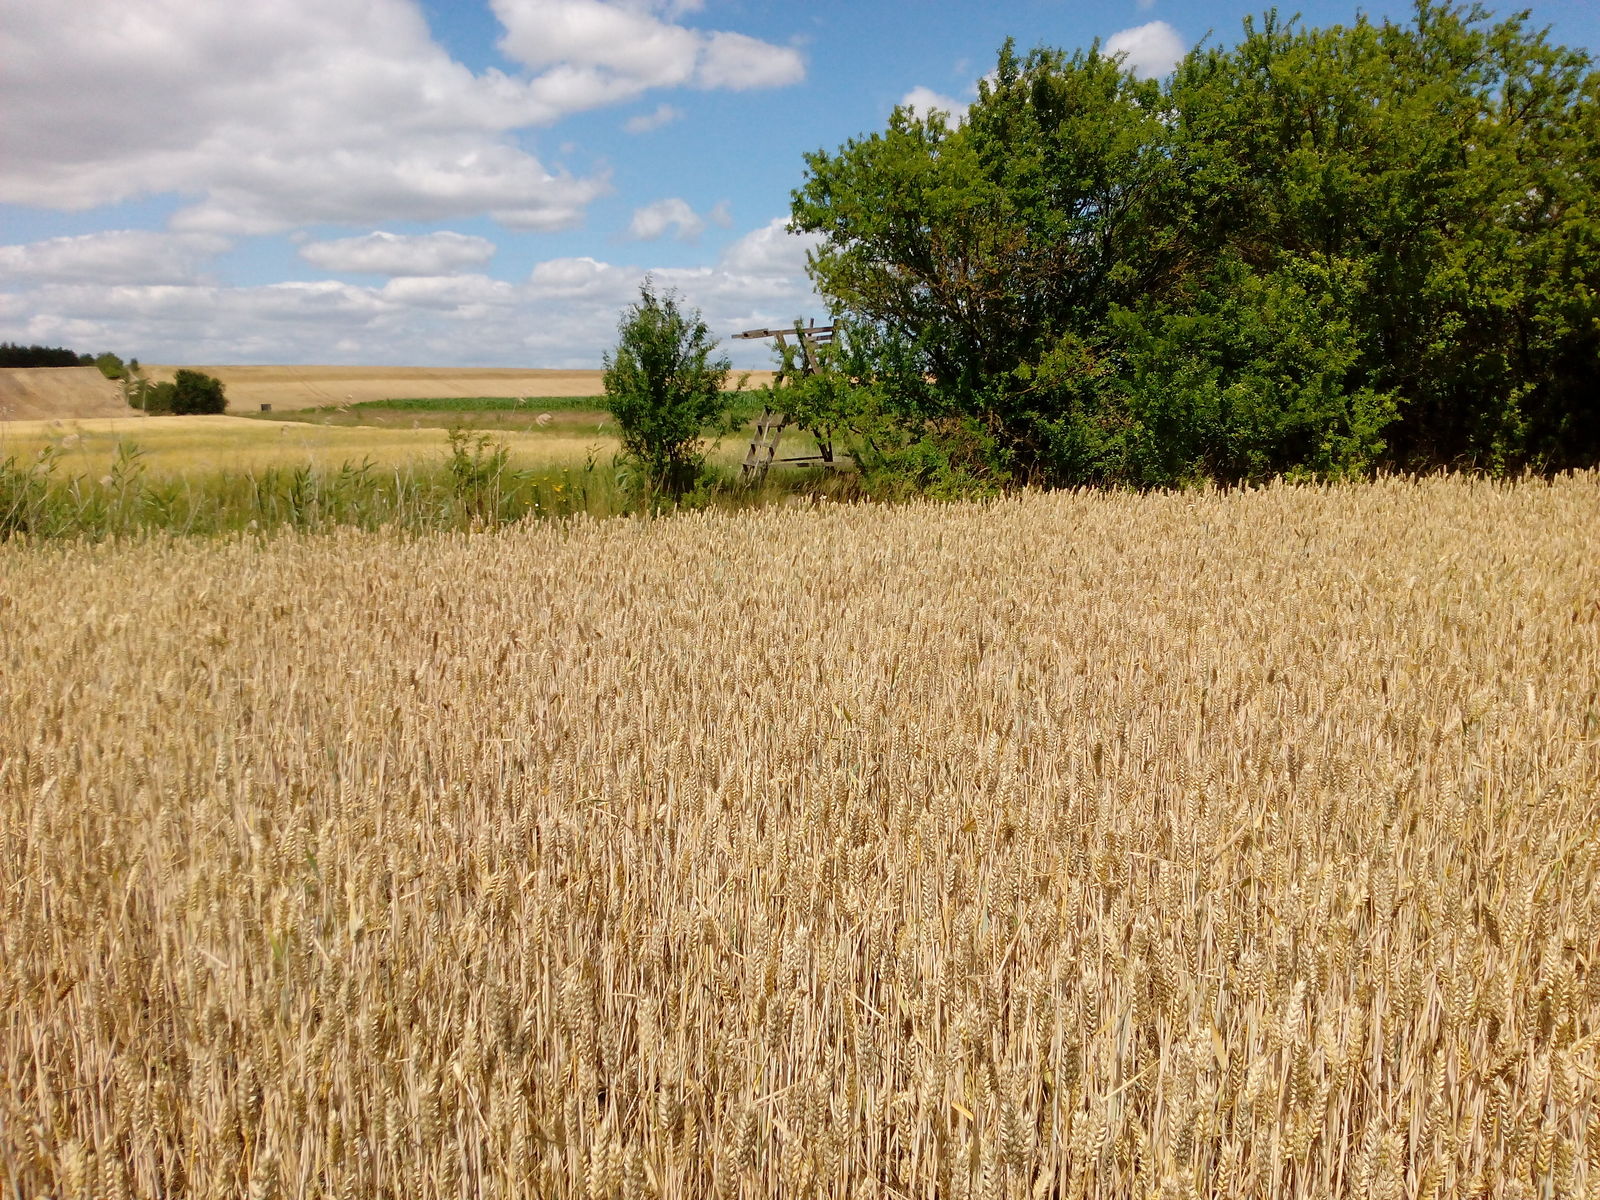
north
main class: Cropland
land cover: Common wheat
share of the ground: > 75 %
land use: Agriculture (excluding fallow land and kitchen gardens)
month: July
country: DE
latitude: 51.2038
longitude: 11.1018
